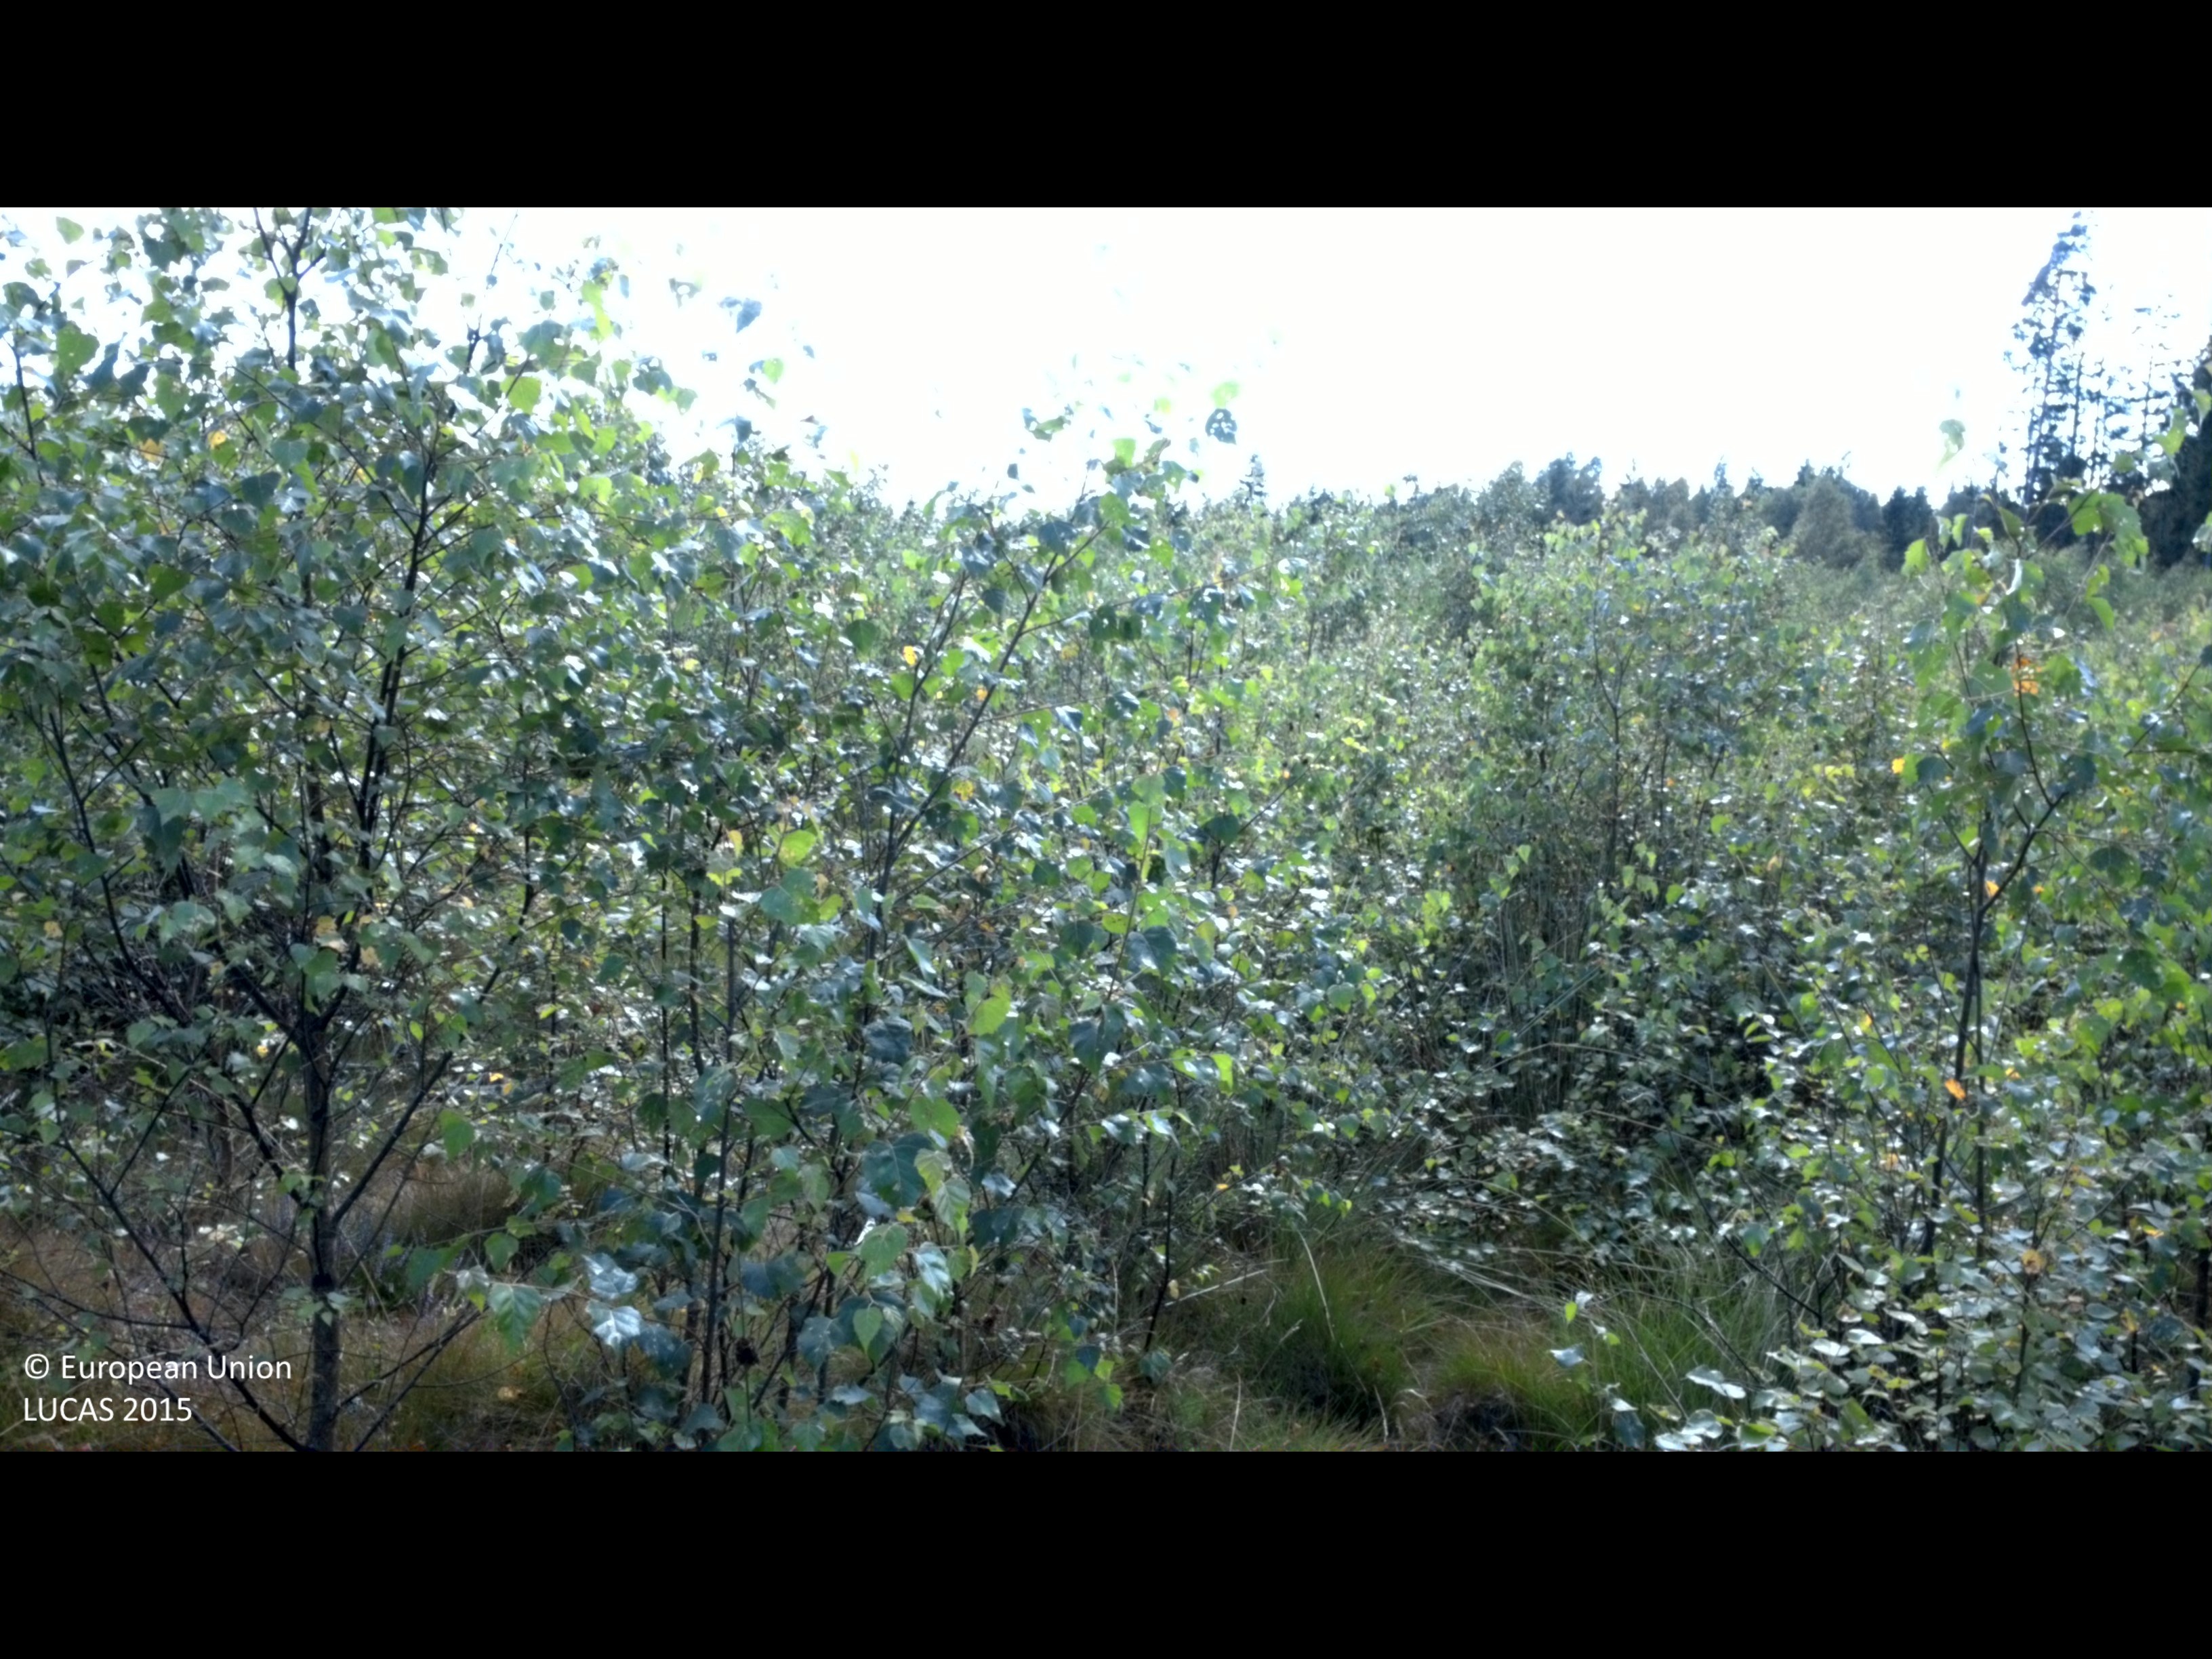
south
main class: Woodland
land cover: Broadleaved woodland
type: boreal forest
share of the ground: 50 - 75 %
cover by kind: broadleaved forest trees 55 %, shrubs 20 %, herbaceous plants 15 %, coniferous forest trees 10 %
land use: Forestry
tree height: < 5 m
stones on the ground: 10 - 25 %
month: August
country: SE
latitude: 56.9776
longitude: 13.7969
